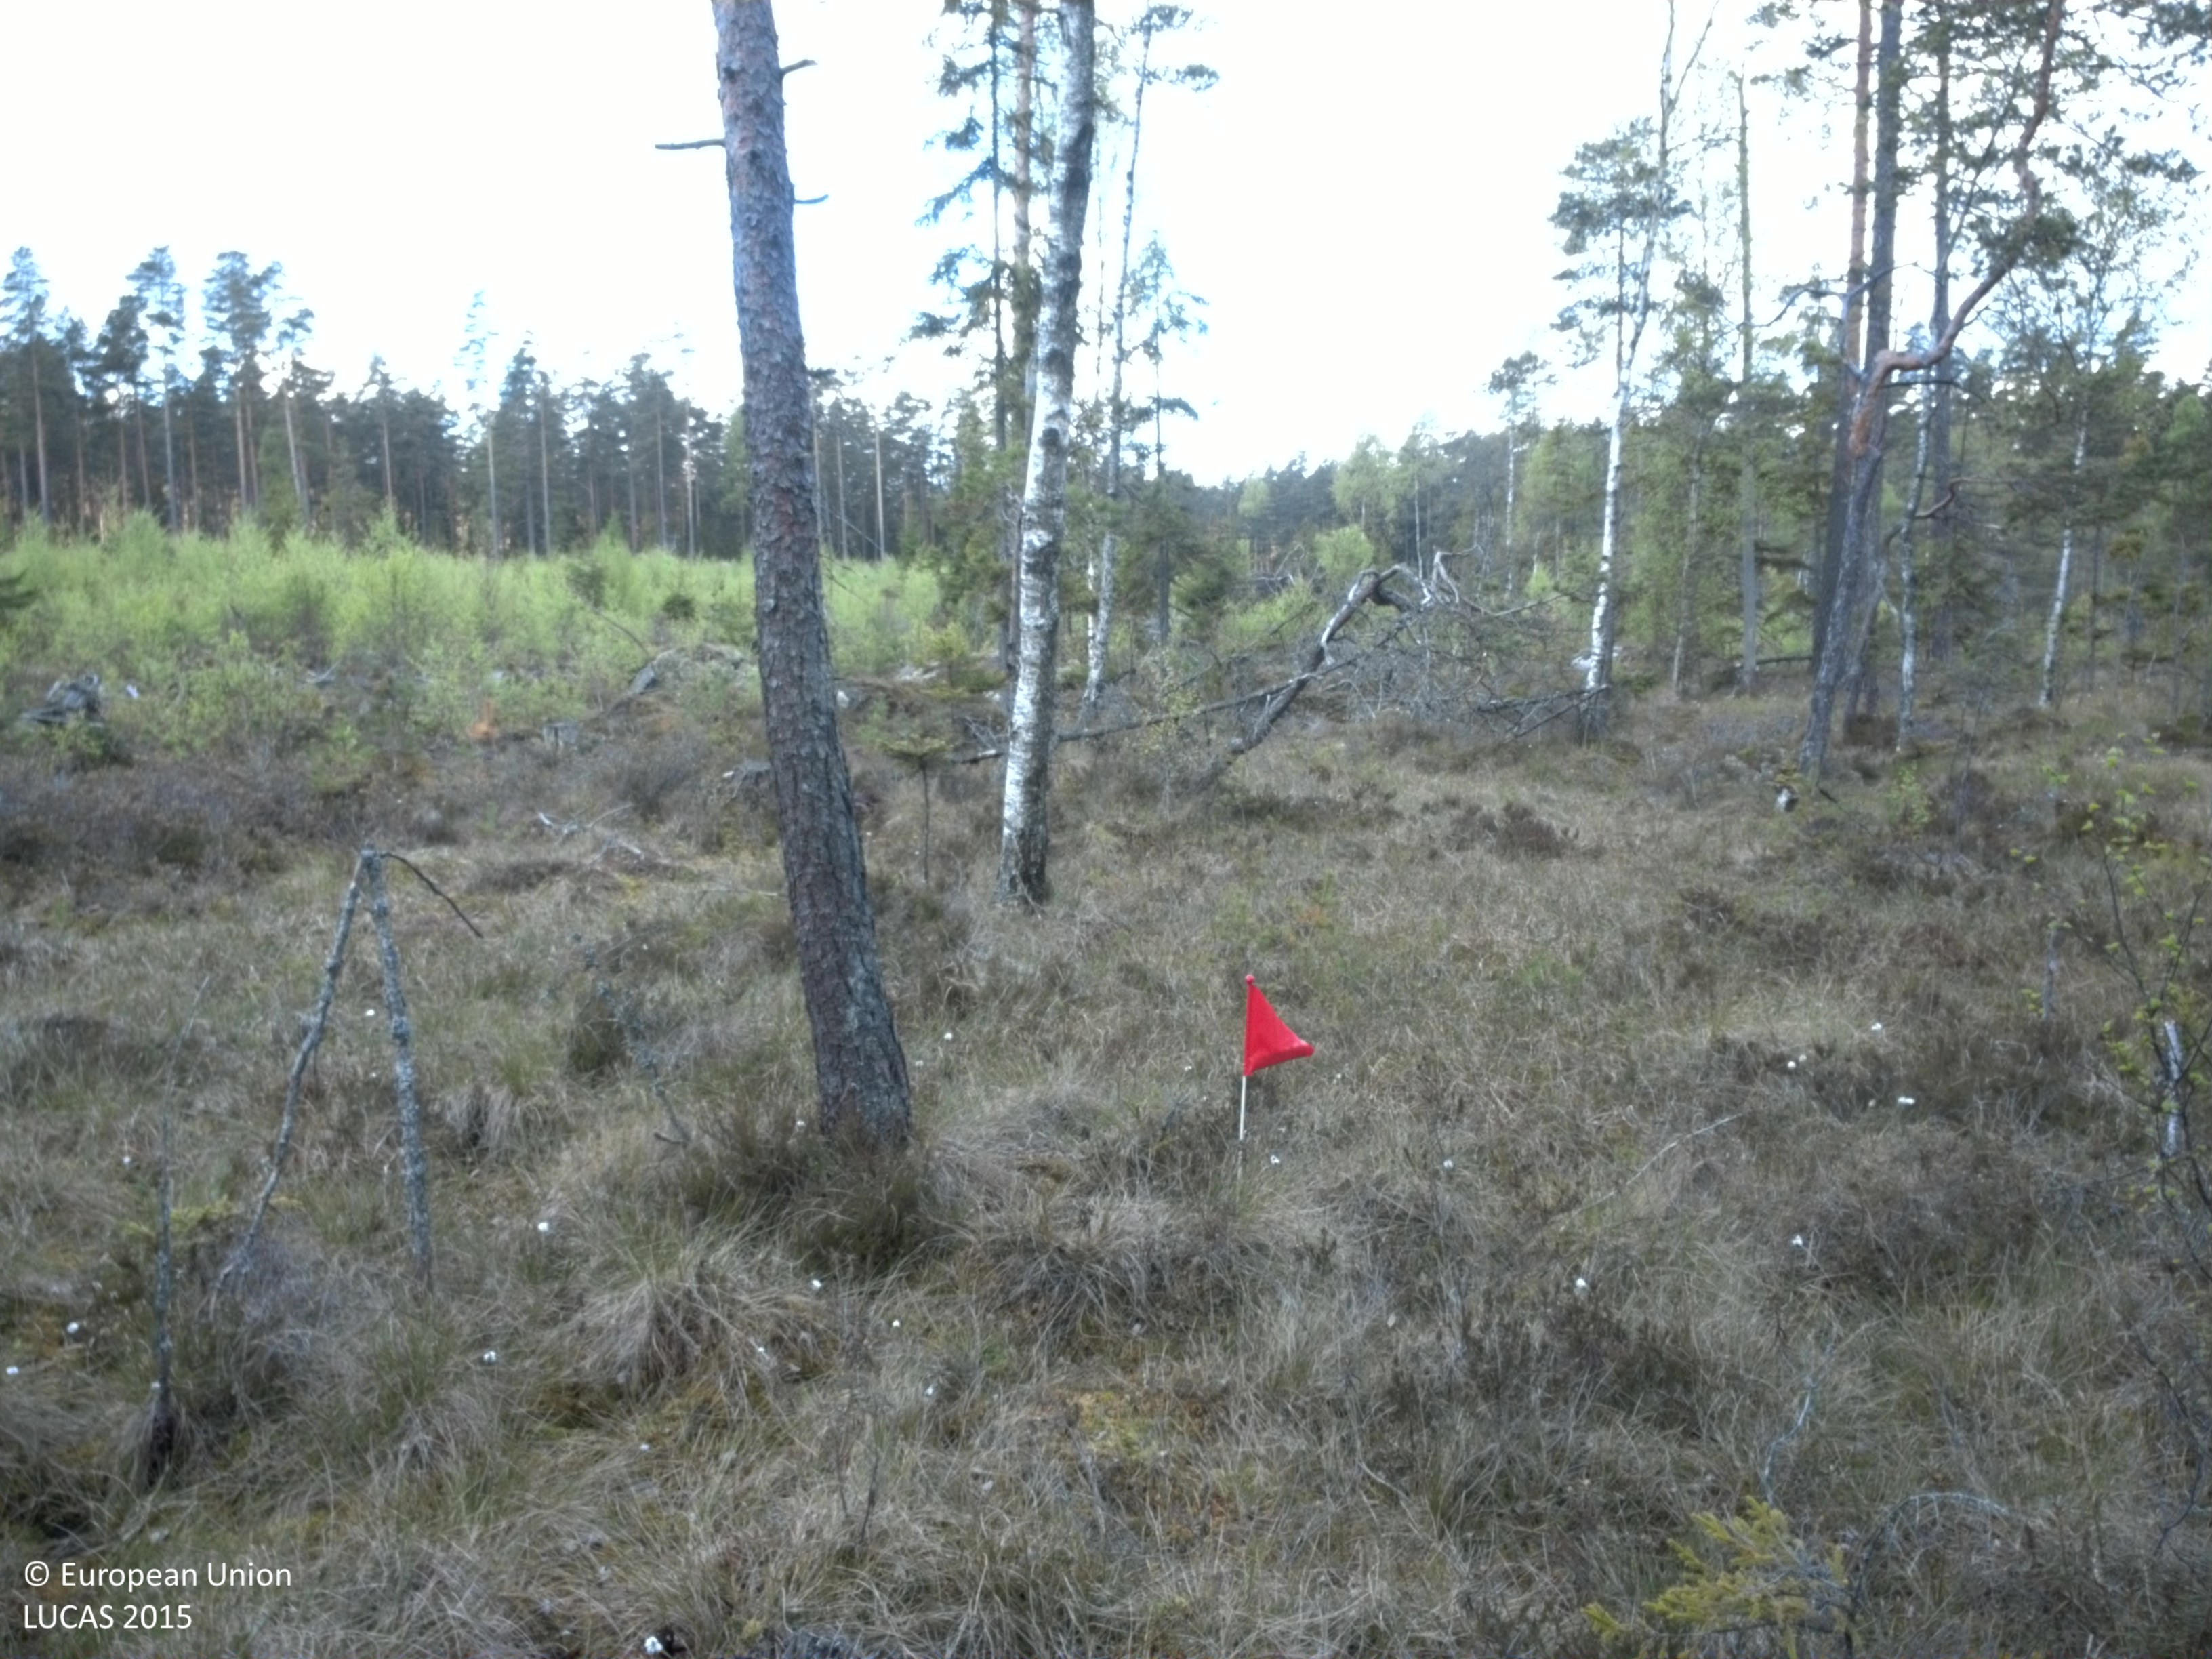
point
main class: Woodland
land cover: Pine dominated mixed woodland
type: boreal forest
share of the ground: 50 - 75 %
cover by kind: coniferous forest trees 35 %, broadleaved forest trees 35 %, lichens and mosses 30 %
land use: Forestry
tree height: > 5 m
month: May
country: SE
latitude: 56.5926
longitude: 14.5735
